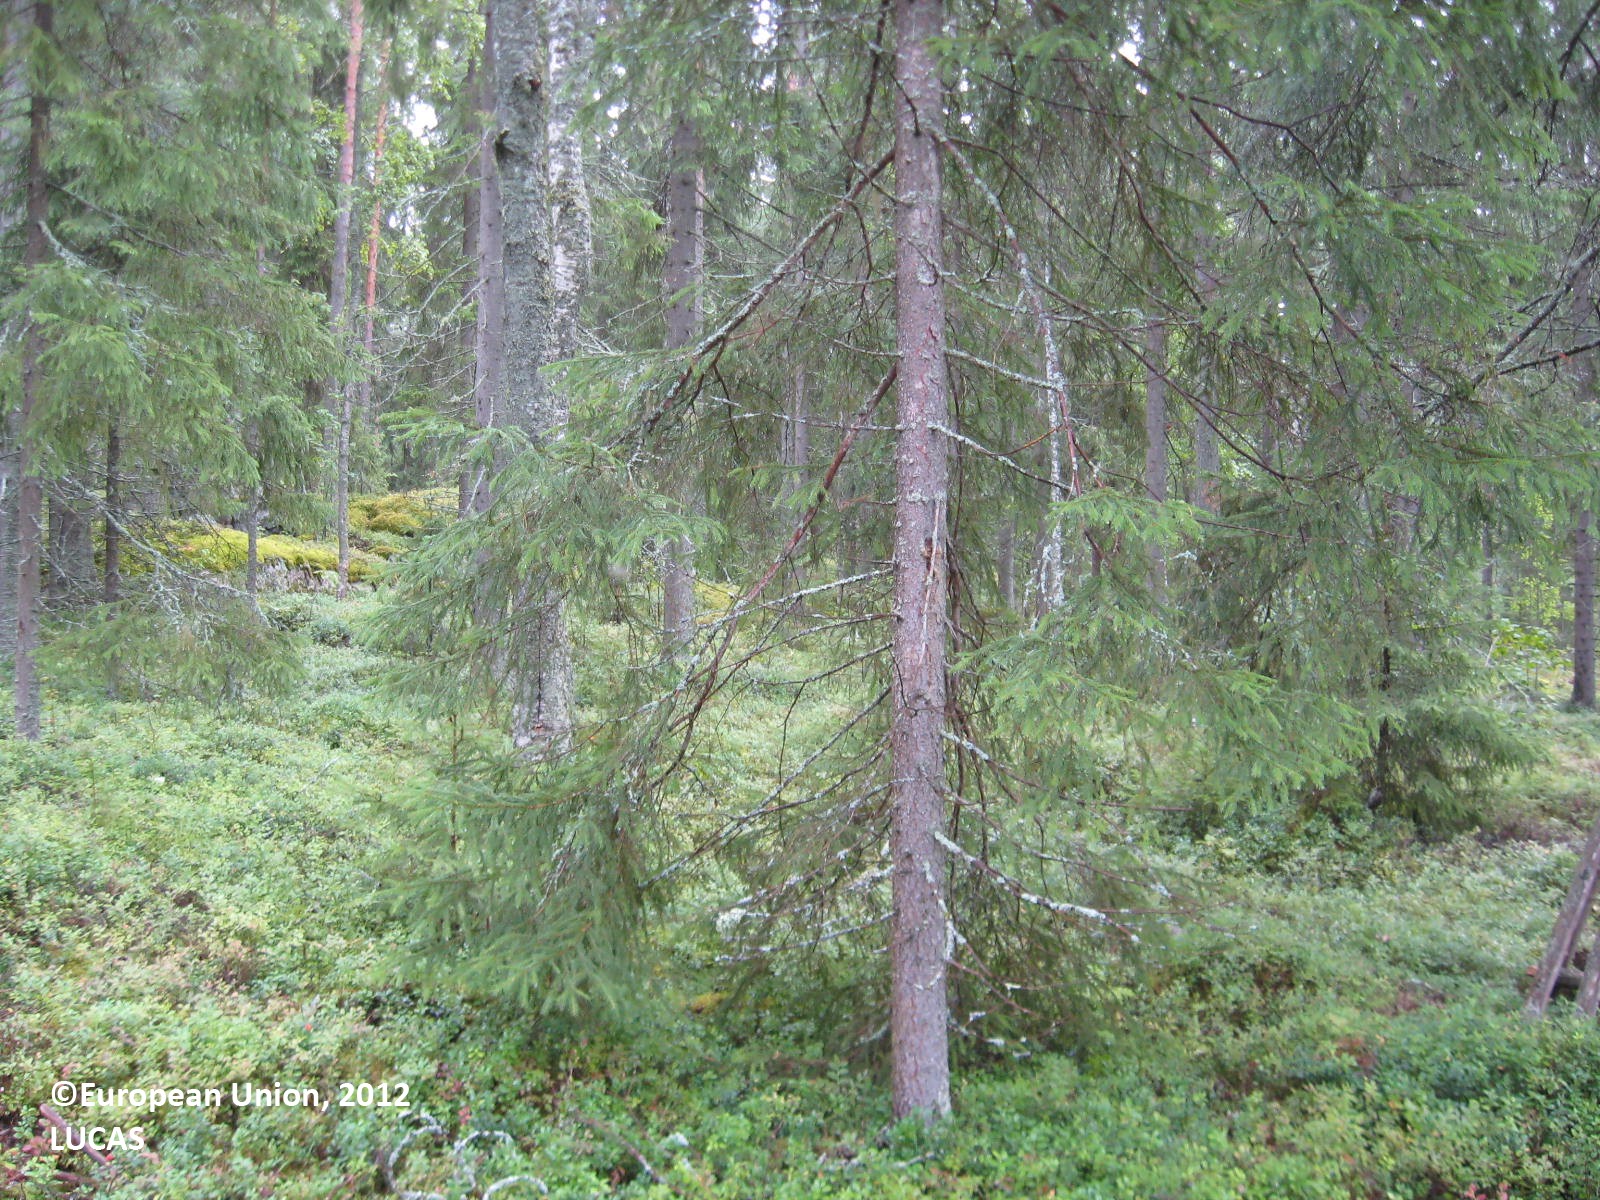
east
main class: Woodland
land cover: Other mixed woodland
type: boreal forest
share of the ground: > 75 %
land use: Forestry
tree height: > 5 m
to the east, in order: Other mixed woodland; Tracks; Other mixed woodland
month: August
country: FI
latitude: 63.3968
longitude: 29.7542
